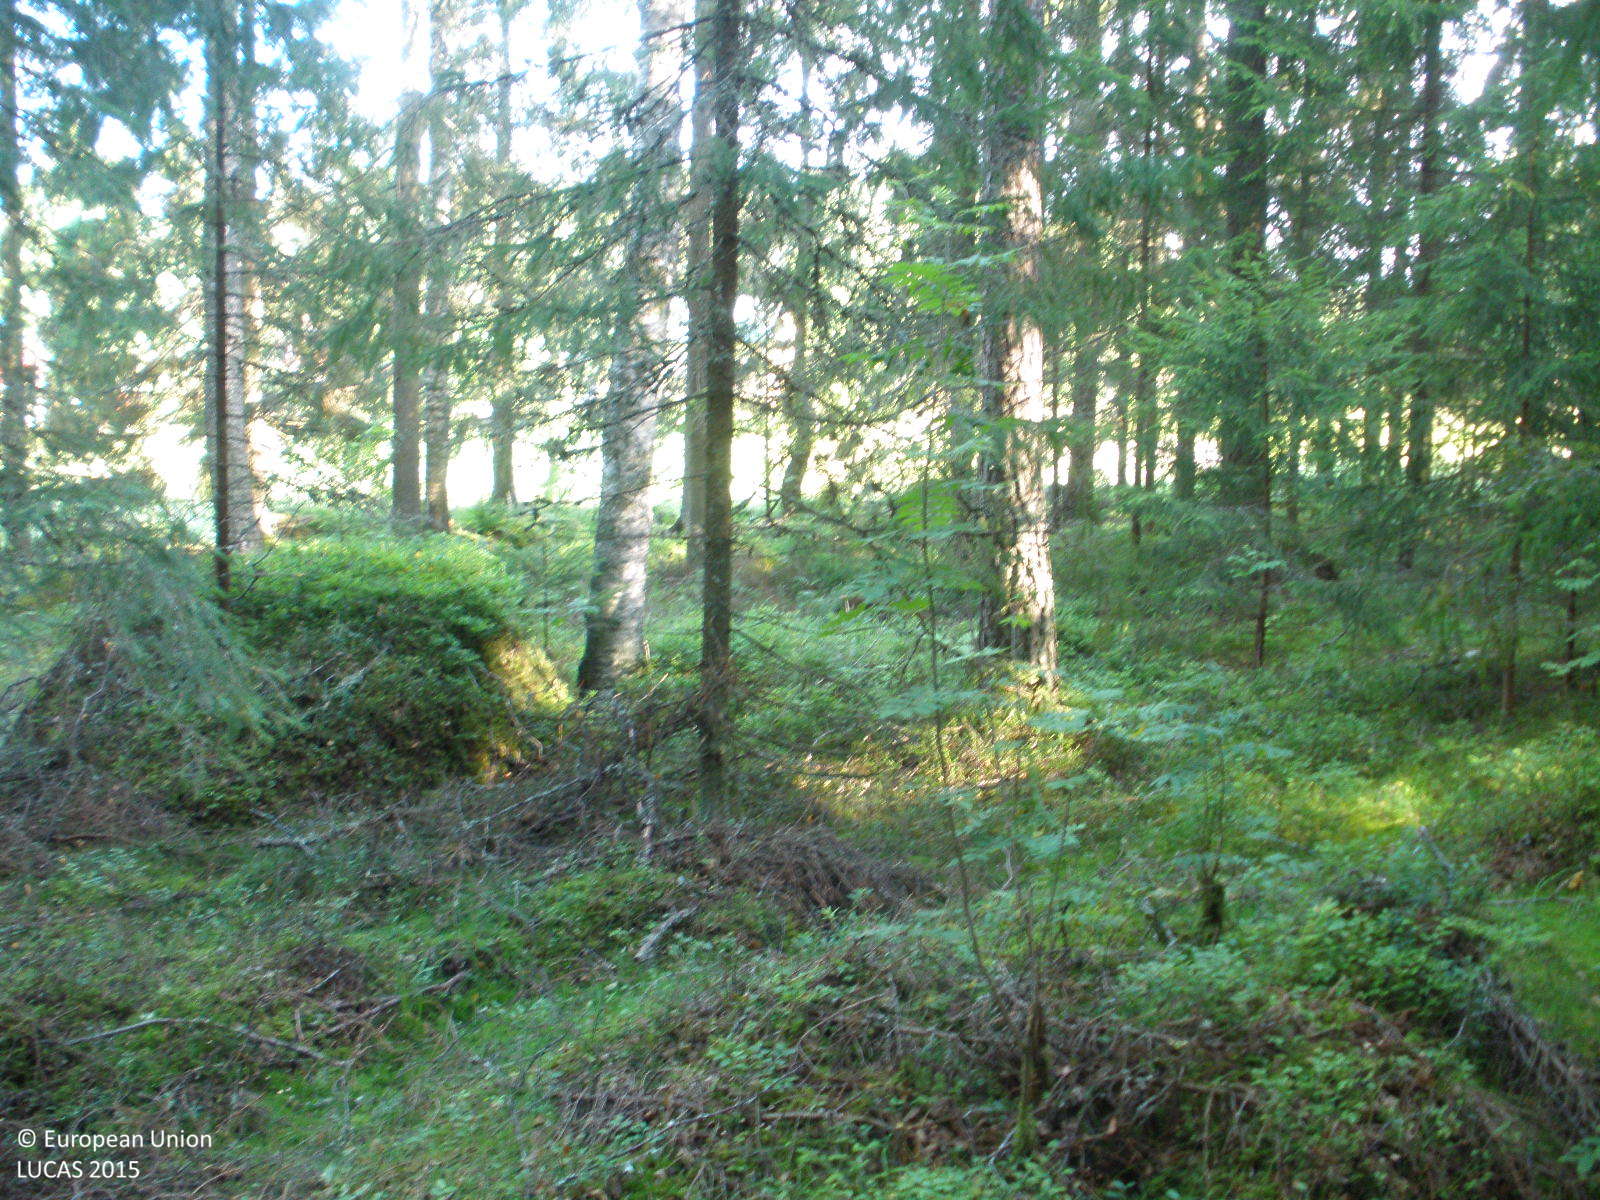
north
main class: Woodland
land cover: Spruce dominated coniferous woodland
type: boreal forest
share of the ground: > 75 %
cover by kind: coniferous forest trees 85 %, shrubs 5 %, herbaceous plants 5 %, lichens and mosses 5 %
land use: Forestry
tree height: > 5 m
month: August
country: FI
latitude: 60.9276
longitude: 24.8892
